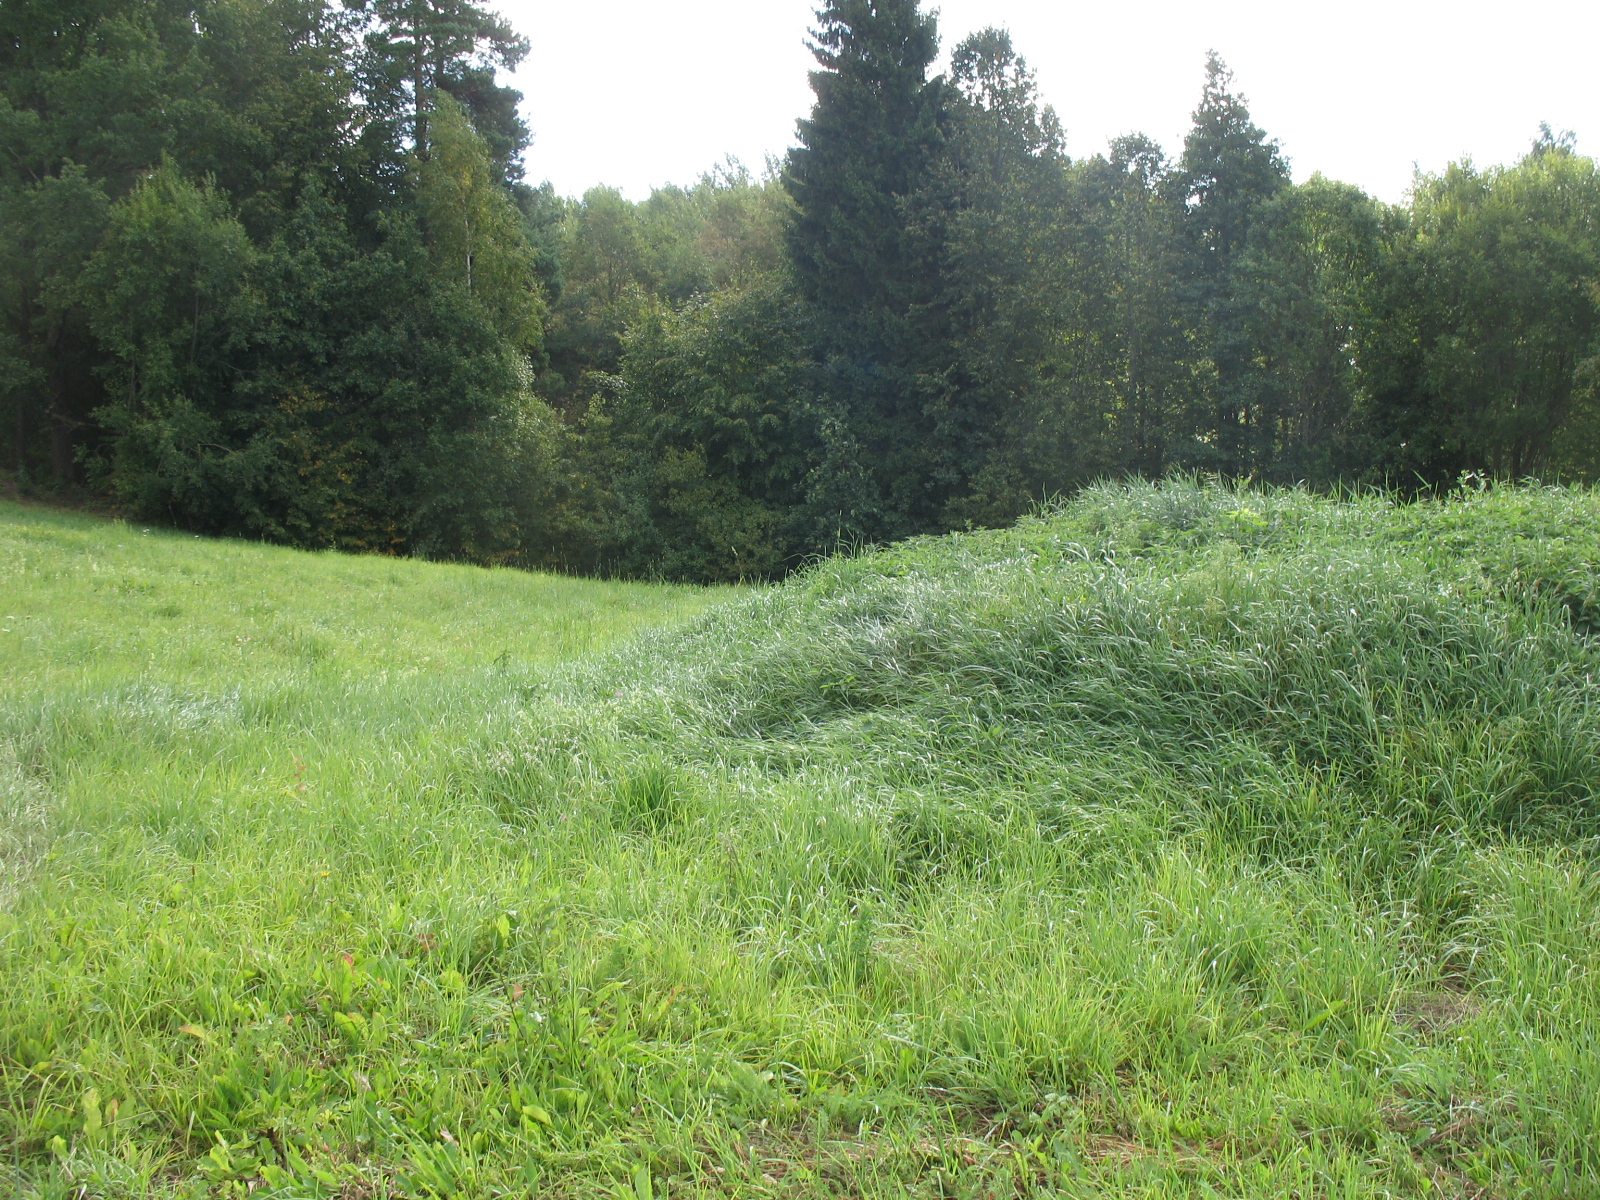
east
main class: Grassland
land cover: Grassland without tree/shrub cover
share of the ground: > 75 %
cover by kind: herbaceous plants 100 %
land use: Residential
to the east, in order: Grassland without tree/shrub cover; Other mixed woodland; Pine dominated mixed woodland; Broadleaved woodland; Spruce dominated mixed woodland
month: August
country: LV
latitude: 56.2753
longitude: 26.0102
